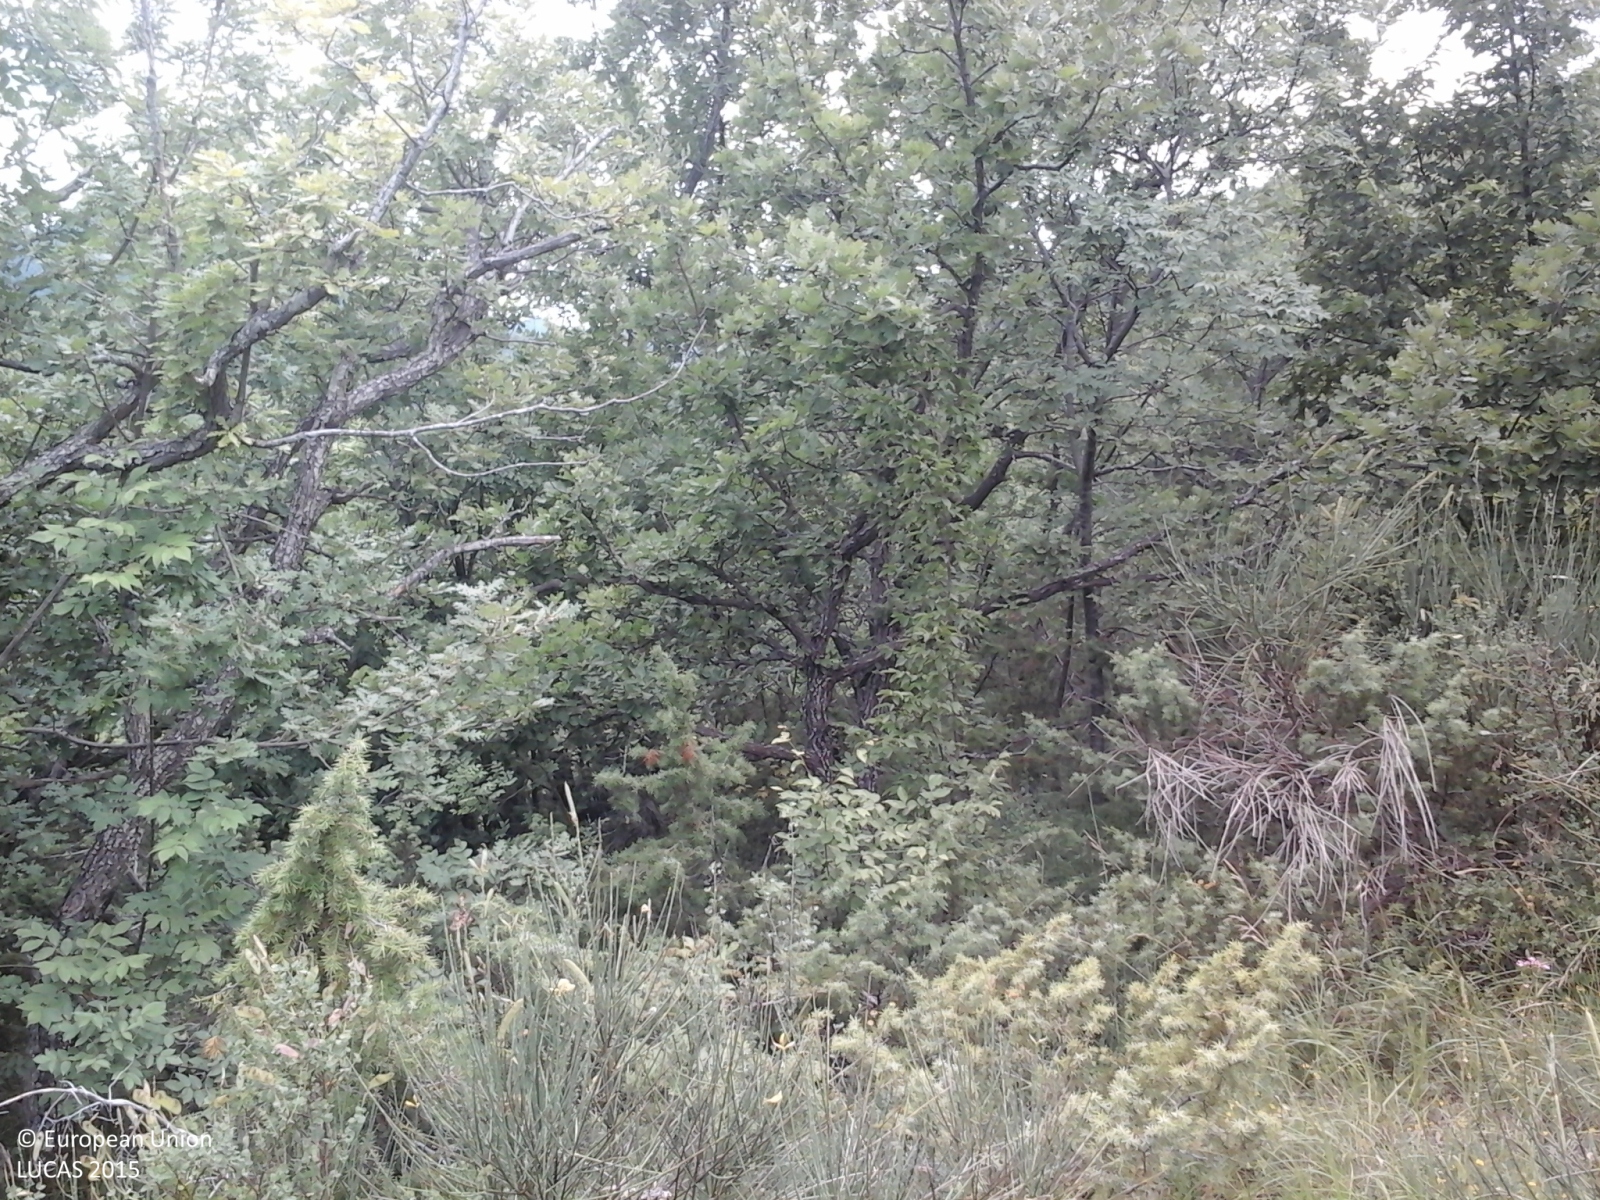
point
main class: Woodland
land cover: Broadleaved woodland
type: thermophilous deciduous forest
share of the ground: > 75 %
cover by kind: broadleaved forest trees 95 %, shrubs 5 %
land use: Semi-natural and natural areas not in use
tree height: > 5 m
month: June
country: IT
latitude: 44.1753
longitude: 11.6347
